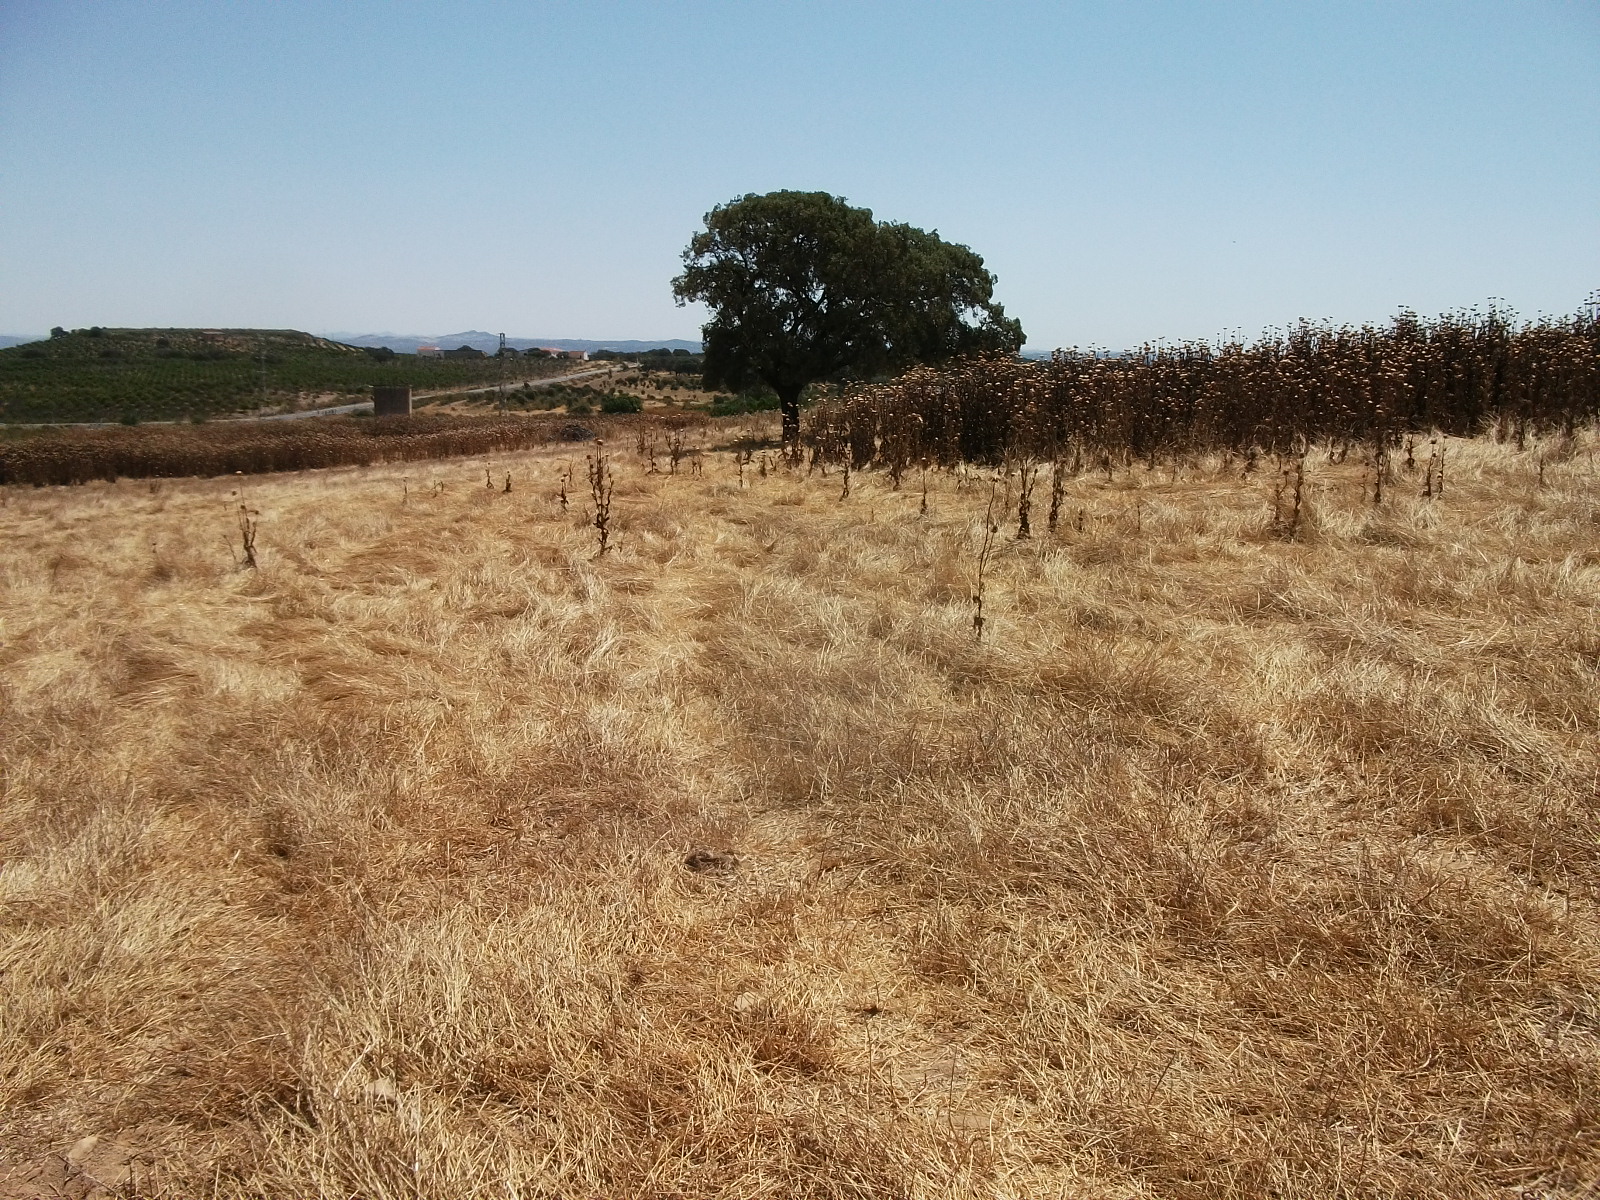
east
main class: Grassland
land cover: Grassland without tree/shrub cover
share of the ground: > 75 %
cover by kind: herbaceous plants 100 %
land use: Agriculture (excluding fallow land and kitchen gardens)
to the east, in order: Grassland without tree/shrub cover; Single bushes/trees; Electric lines; Grass margins; Tracks
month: June
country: ES
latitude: 37.6095
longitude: -7.0971
